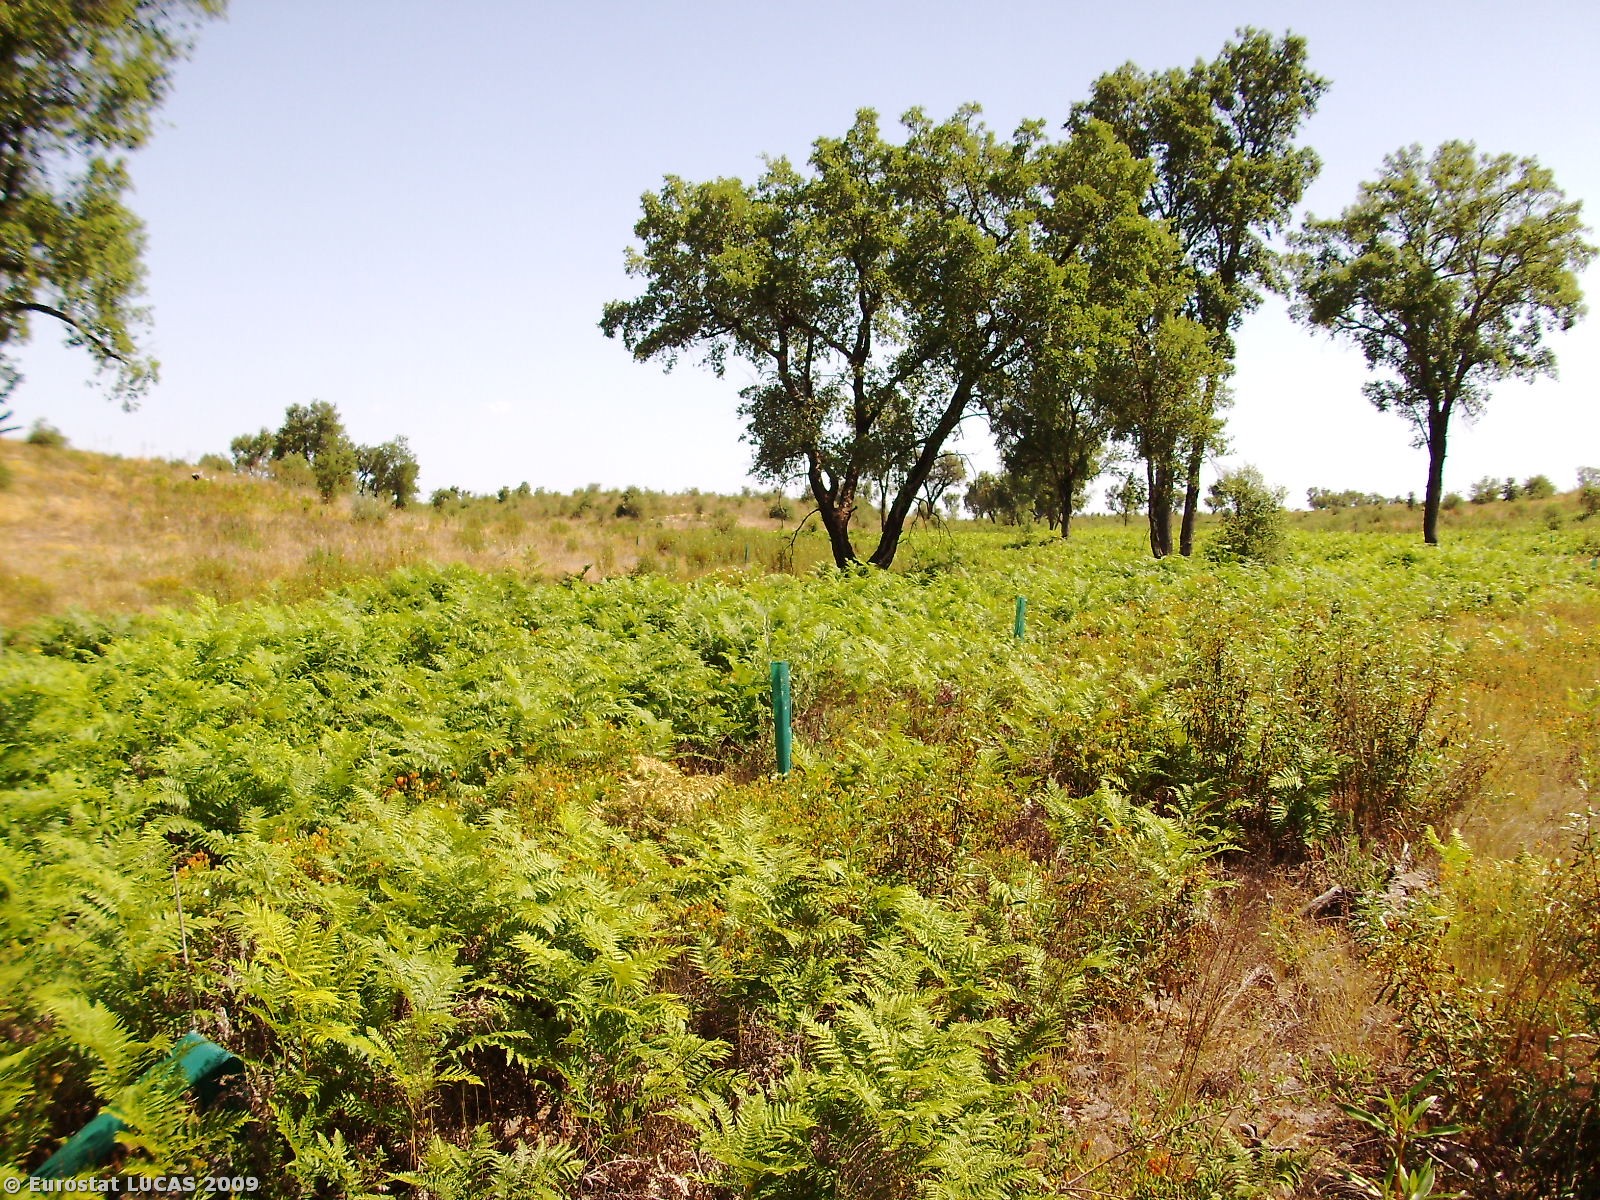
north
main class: Woodland
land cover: Broadleaved woodland
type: broadleaved evergreen forest
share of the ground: 25 - 50 %
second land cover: Shrubland with sparse tree cover
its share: 50 - 75 %
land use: Forestry
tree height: > 5 m
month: June
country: PT
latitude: 39.3866
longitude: -7.8755
